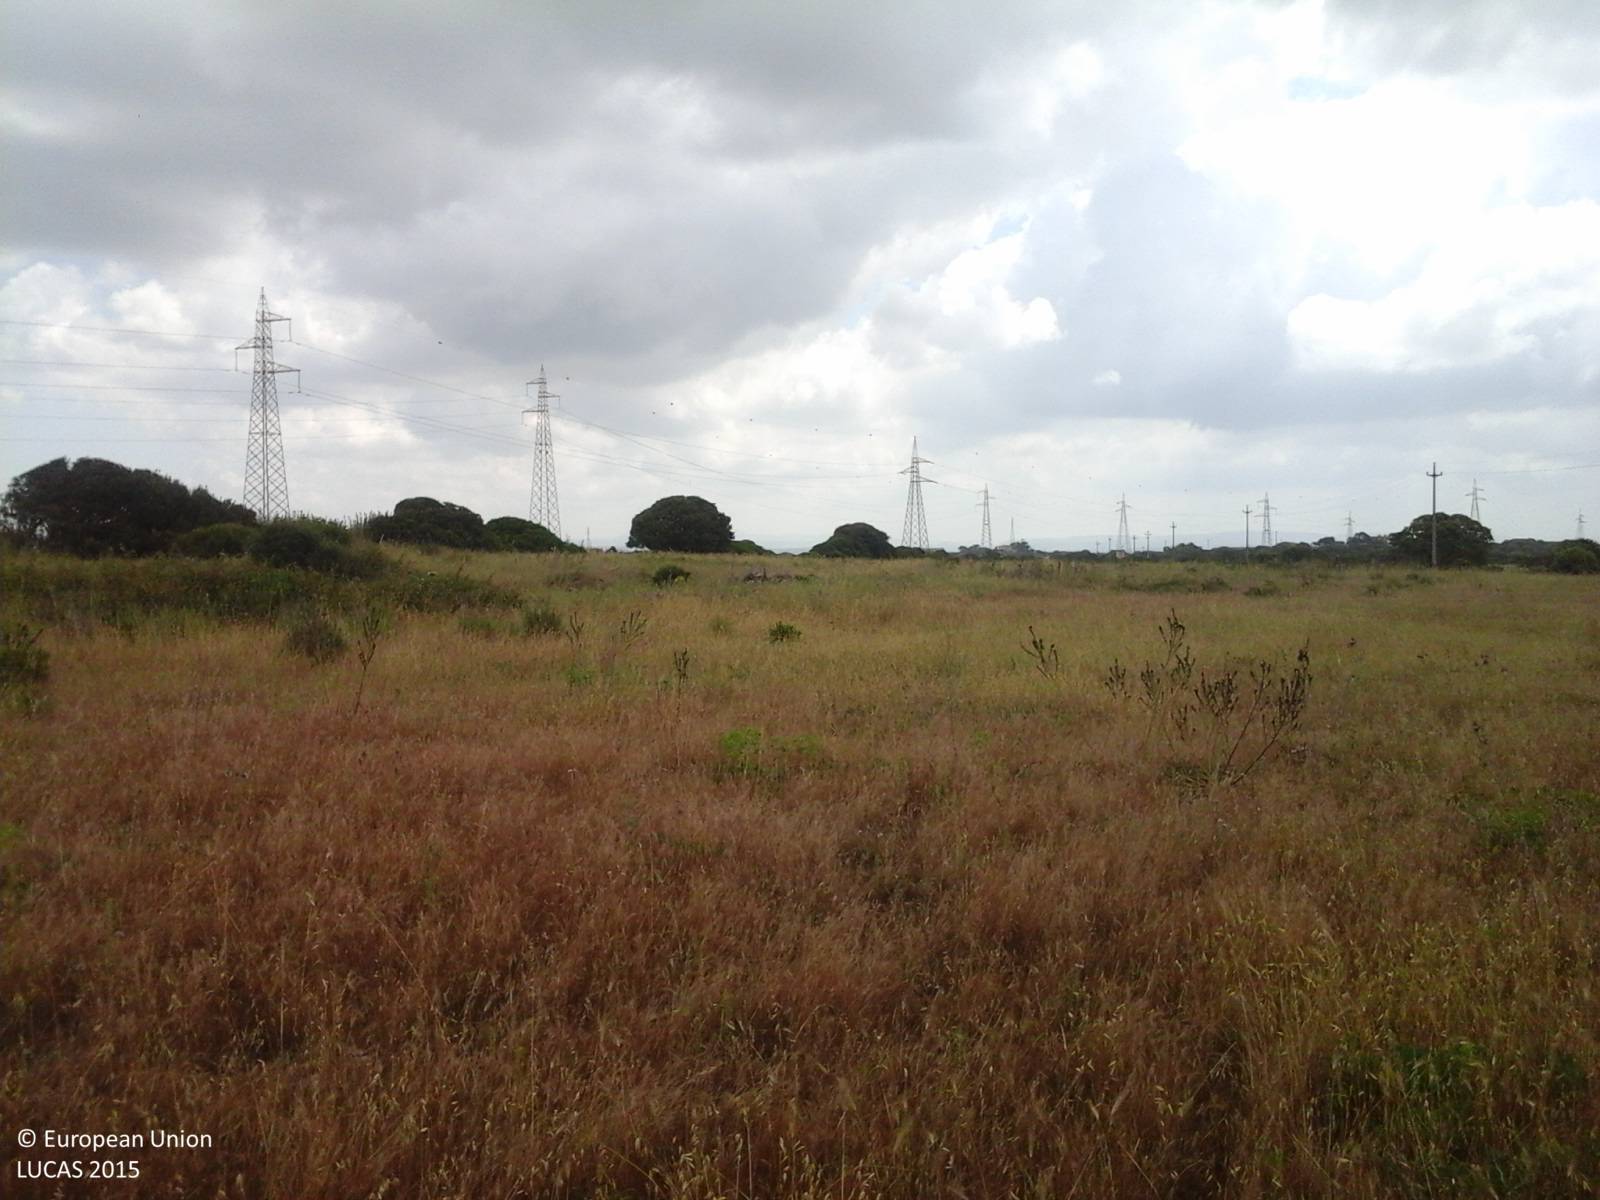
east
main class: Grassland
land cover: Grassland without tree/shrub cover
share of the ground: > 75 %
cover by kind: herbaceous plants 100 %
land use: Agriculture (excluding fallow land and kitchen gardens)
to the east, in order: Grassland without tree/shrub cover; Fences; Shrubland with sparse tree cover
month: May
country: IT
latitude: 40.7058
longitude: 8.3391
